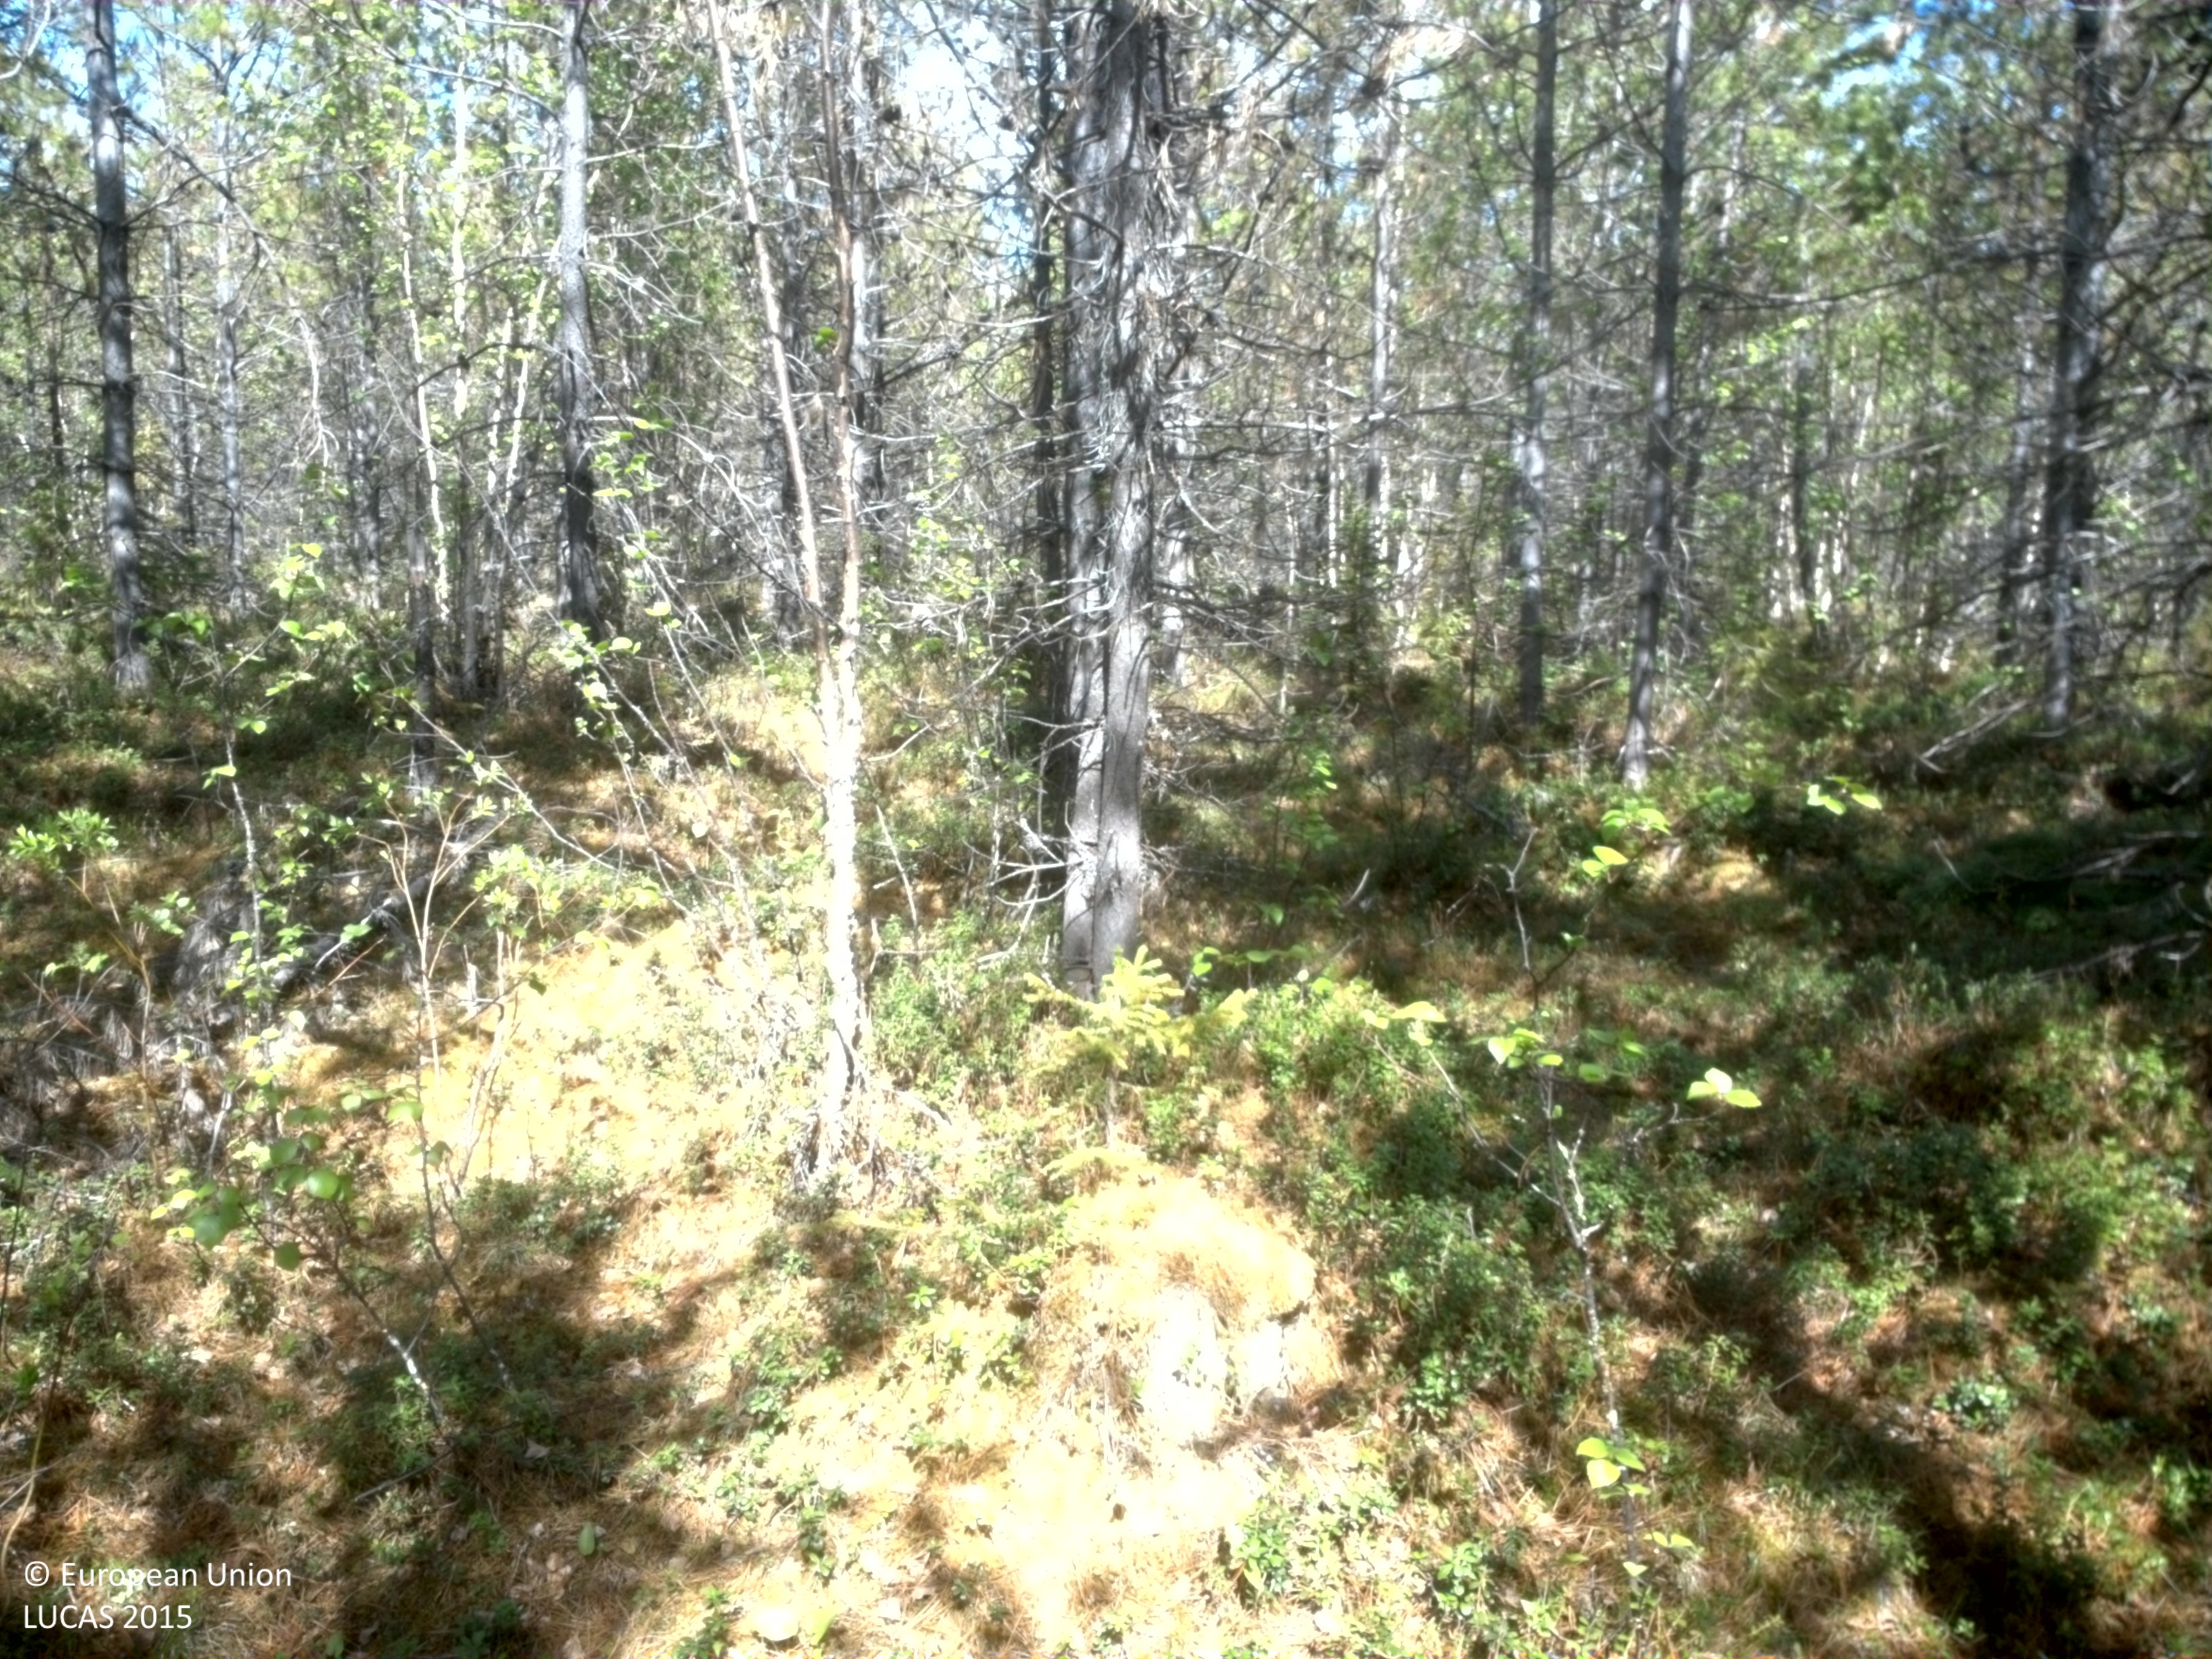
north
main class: Woodland
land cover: Pine dominated mixed woodland
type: boreal forest
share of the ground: 50 - 75 %
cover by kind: coniferous forest trees 40 %, shrubs 35 %, broadleaved forest trees 15 %, lichens and mosses 10 %
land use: Forestry
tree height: > 5 m
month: June
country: SE
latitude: 66.8821
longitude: 21.8979
